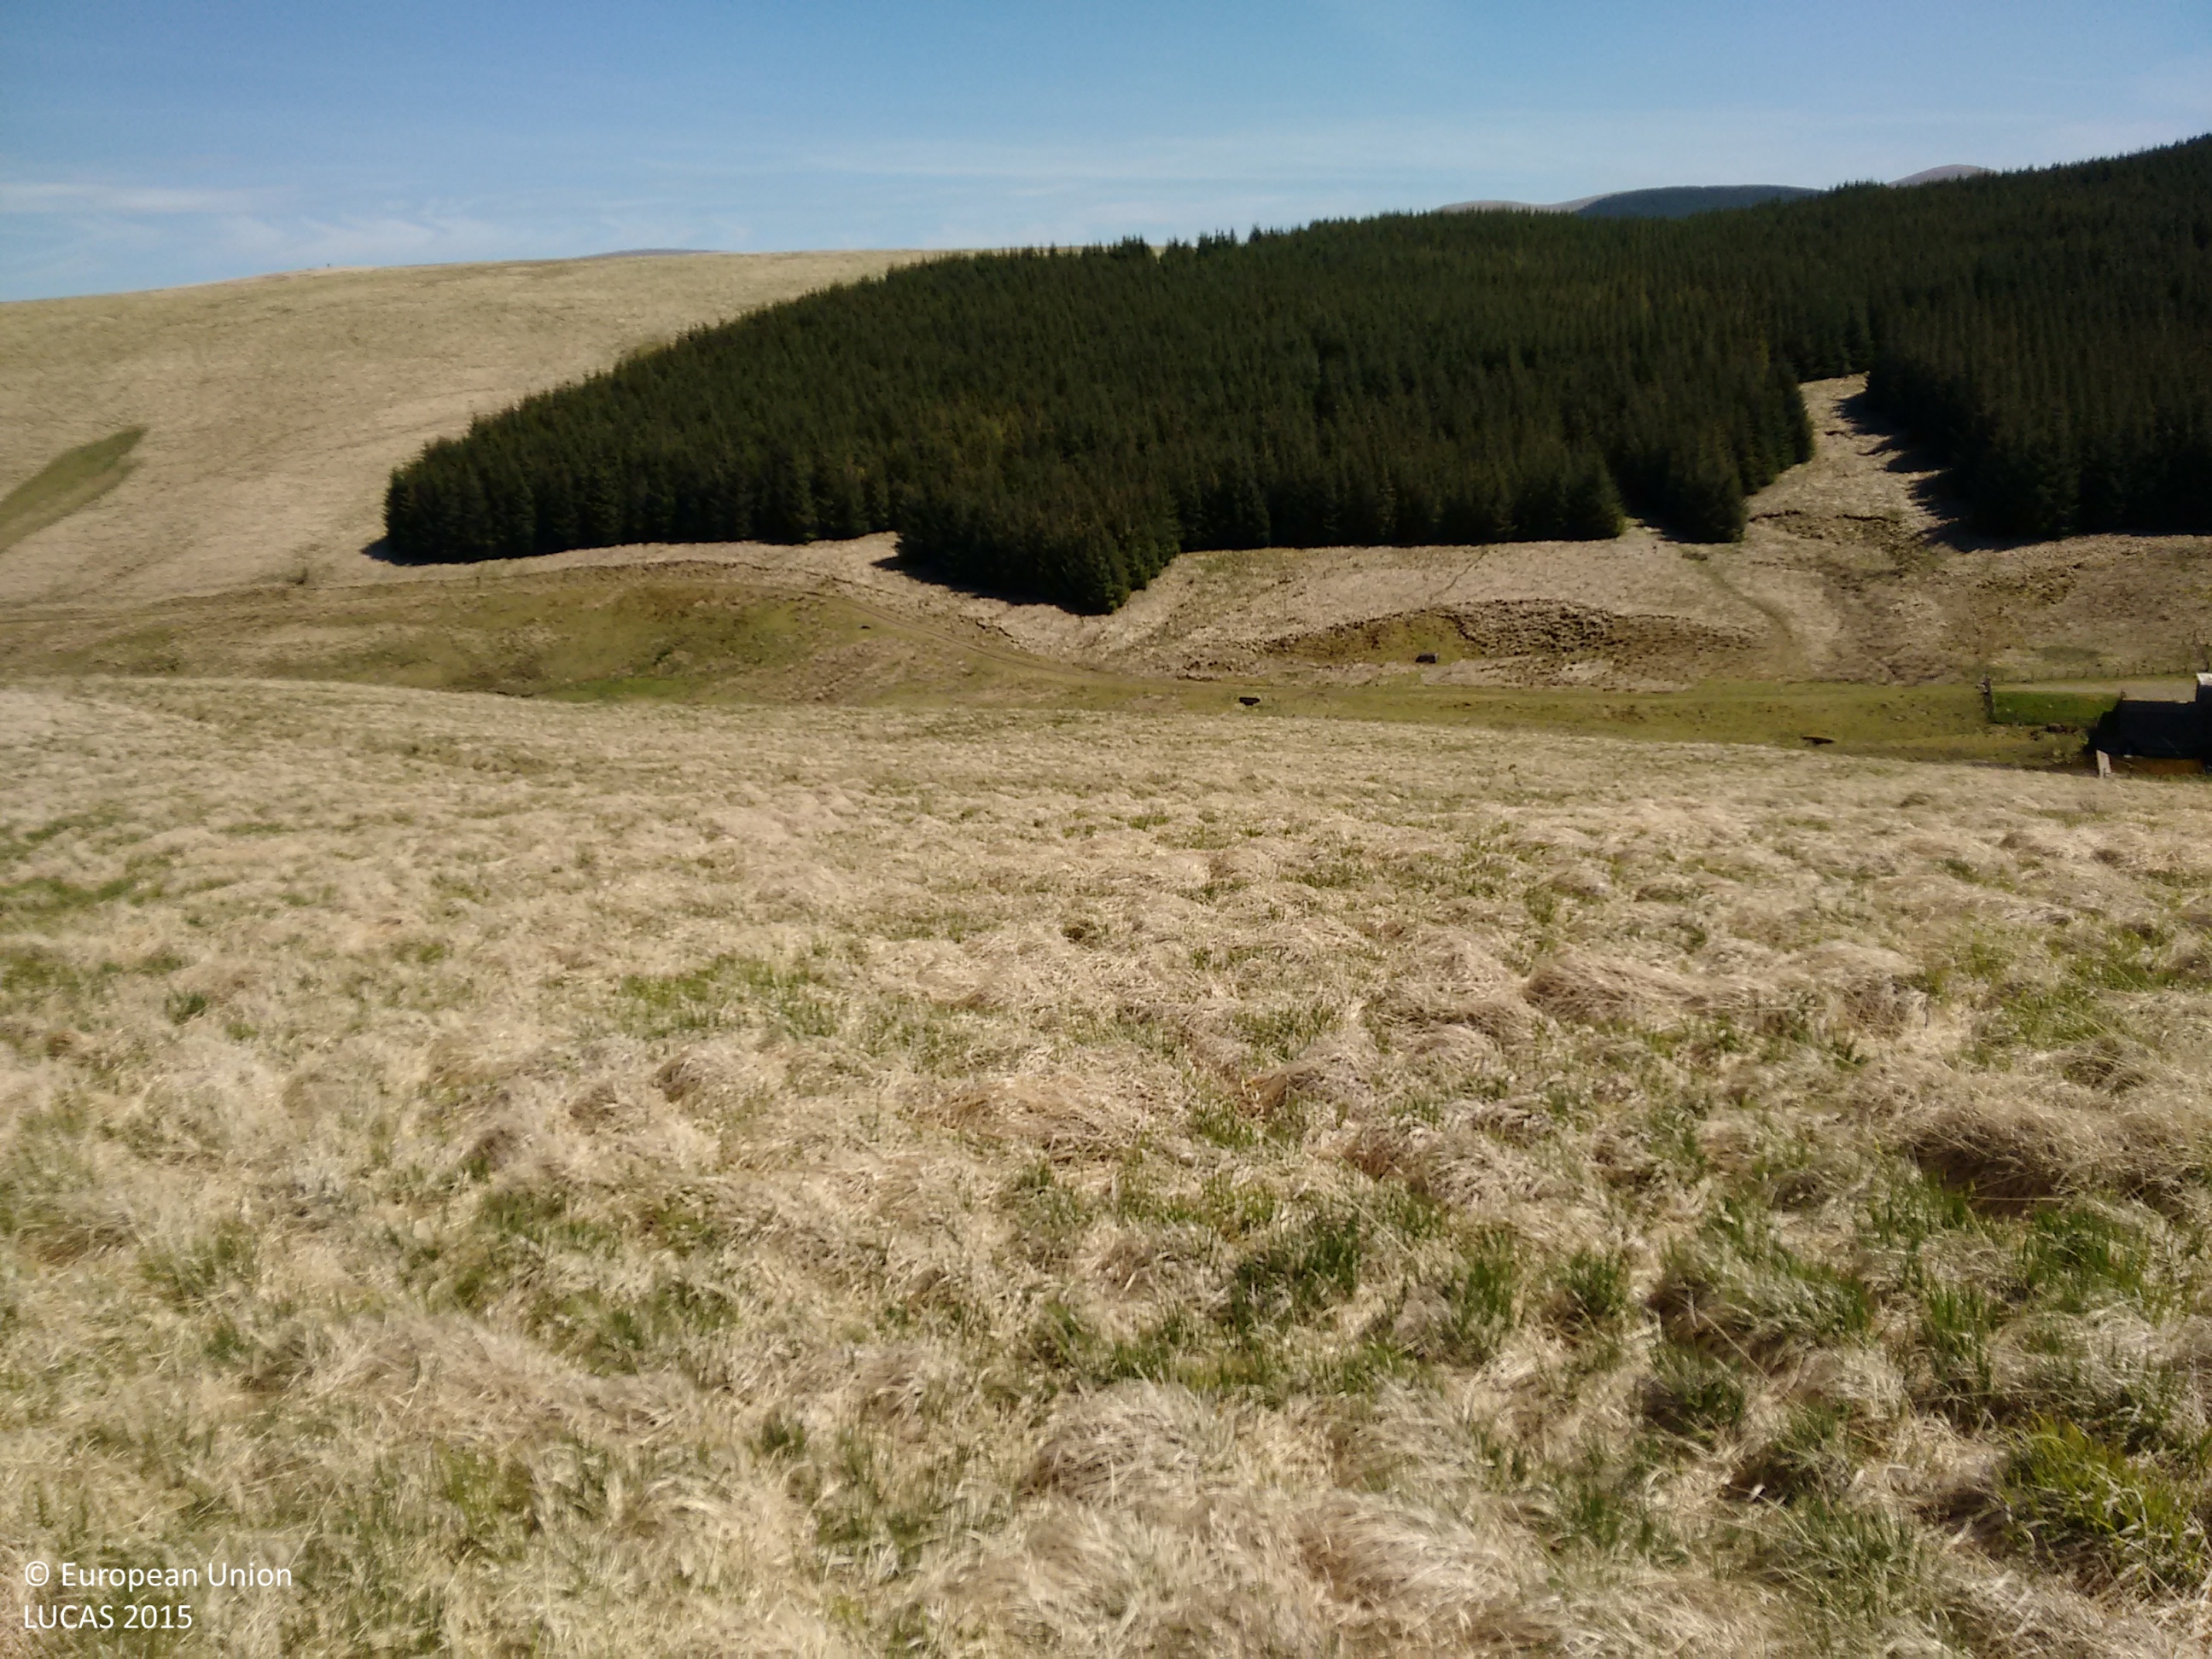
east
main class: Grassland
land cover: Grassland without tree/shrub cover
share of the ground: > 75 %
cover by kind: herbaceous plants 100 %
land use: Semi-natural and natural areas not in use
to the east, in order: Grassland without tree/shrub cover; Ditches and canals; Grassland without tree/shrub cover; Fences; Broadleaved woodland; Grassland without tree/shrub cover; Rivers and streams; Grassland without tree/shrub cover; Tracks; Grassland without tree/shrub cover
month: June
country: GB
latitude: 55.4723
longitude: -3.4779
